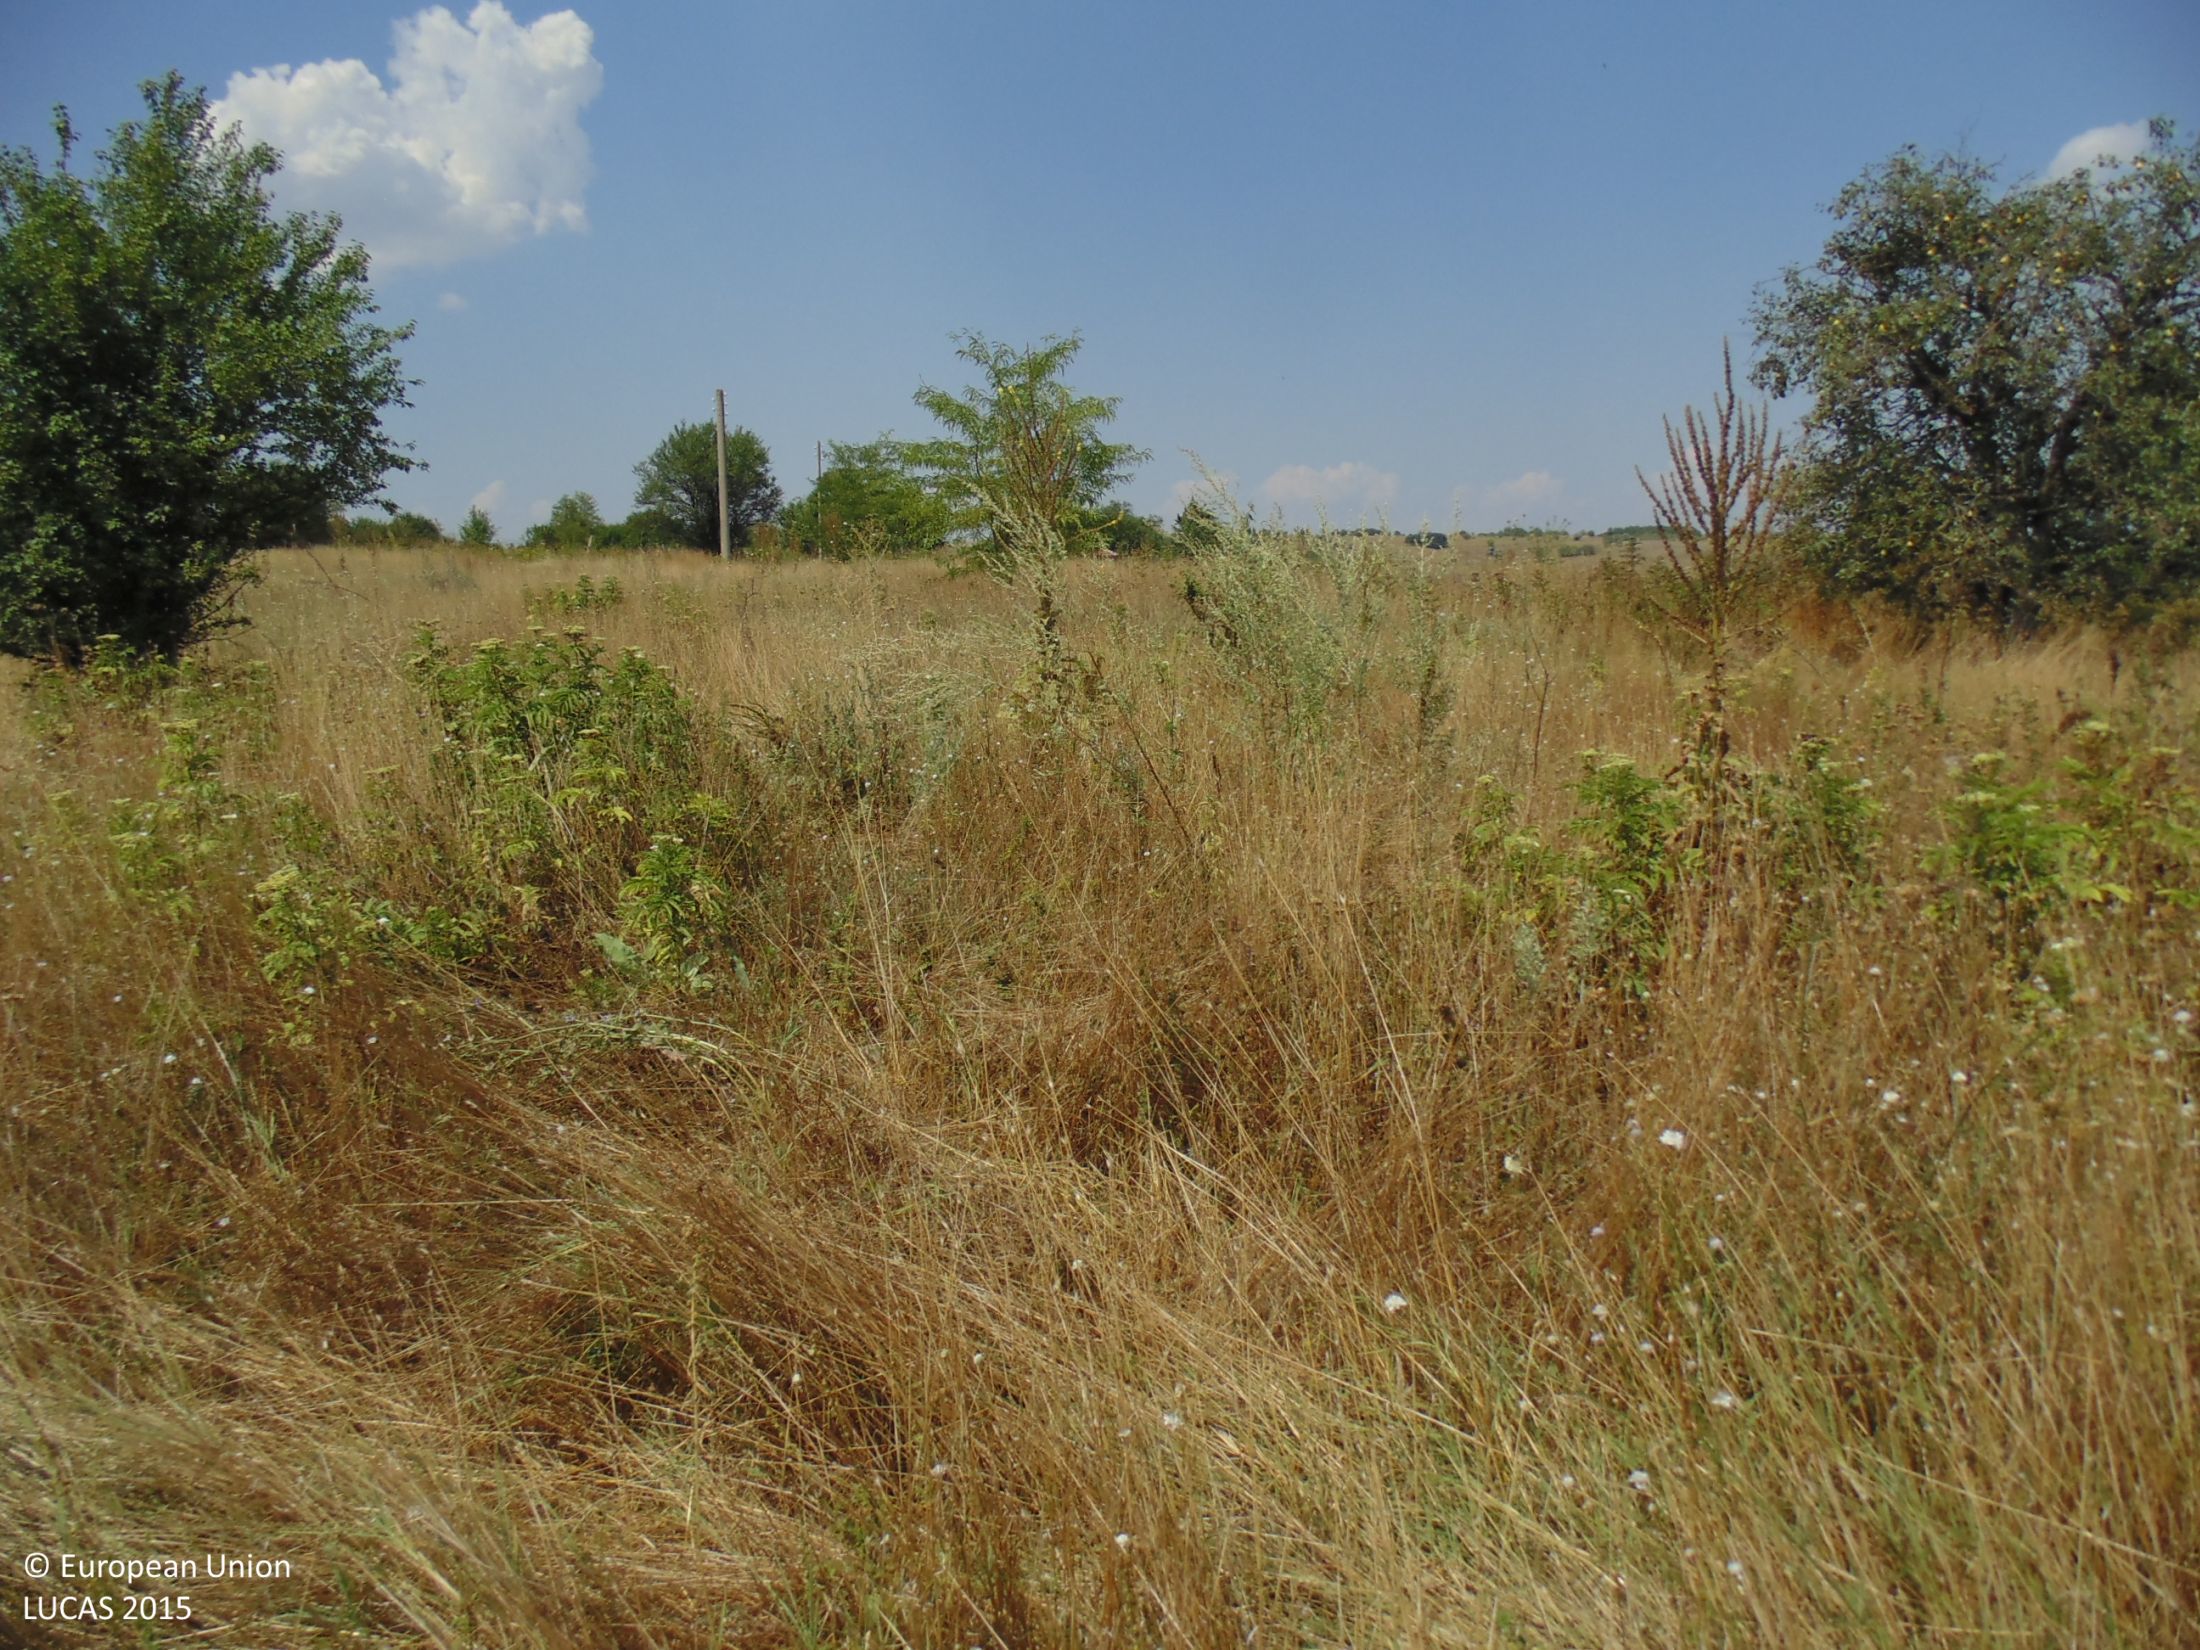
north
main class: Grassland
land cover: Grassland with sparse tree/shrub cover
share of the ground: > 75 %
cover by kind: herbaceous plants 90 %, broadleaved forest trees 5 %, shrubs 5 %
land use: Agriculture (excluding fallow land and kitchen gardens)
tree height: < 5 m
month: August
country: BG
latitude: 44.0043
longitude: 27.6391
